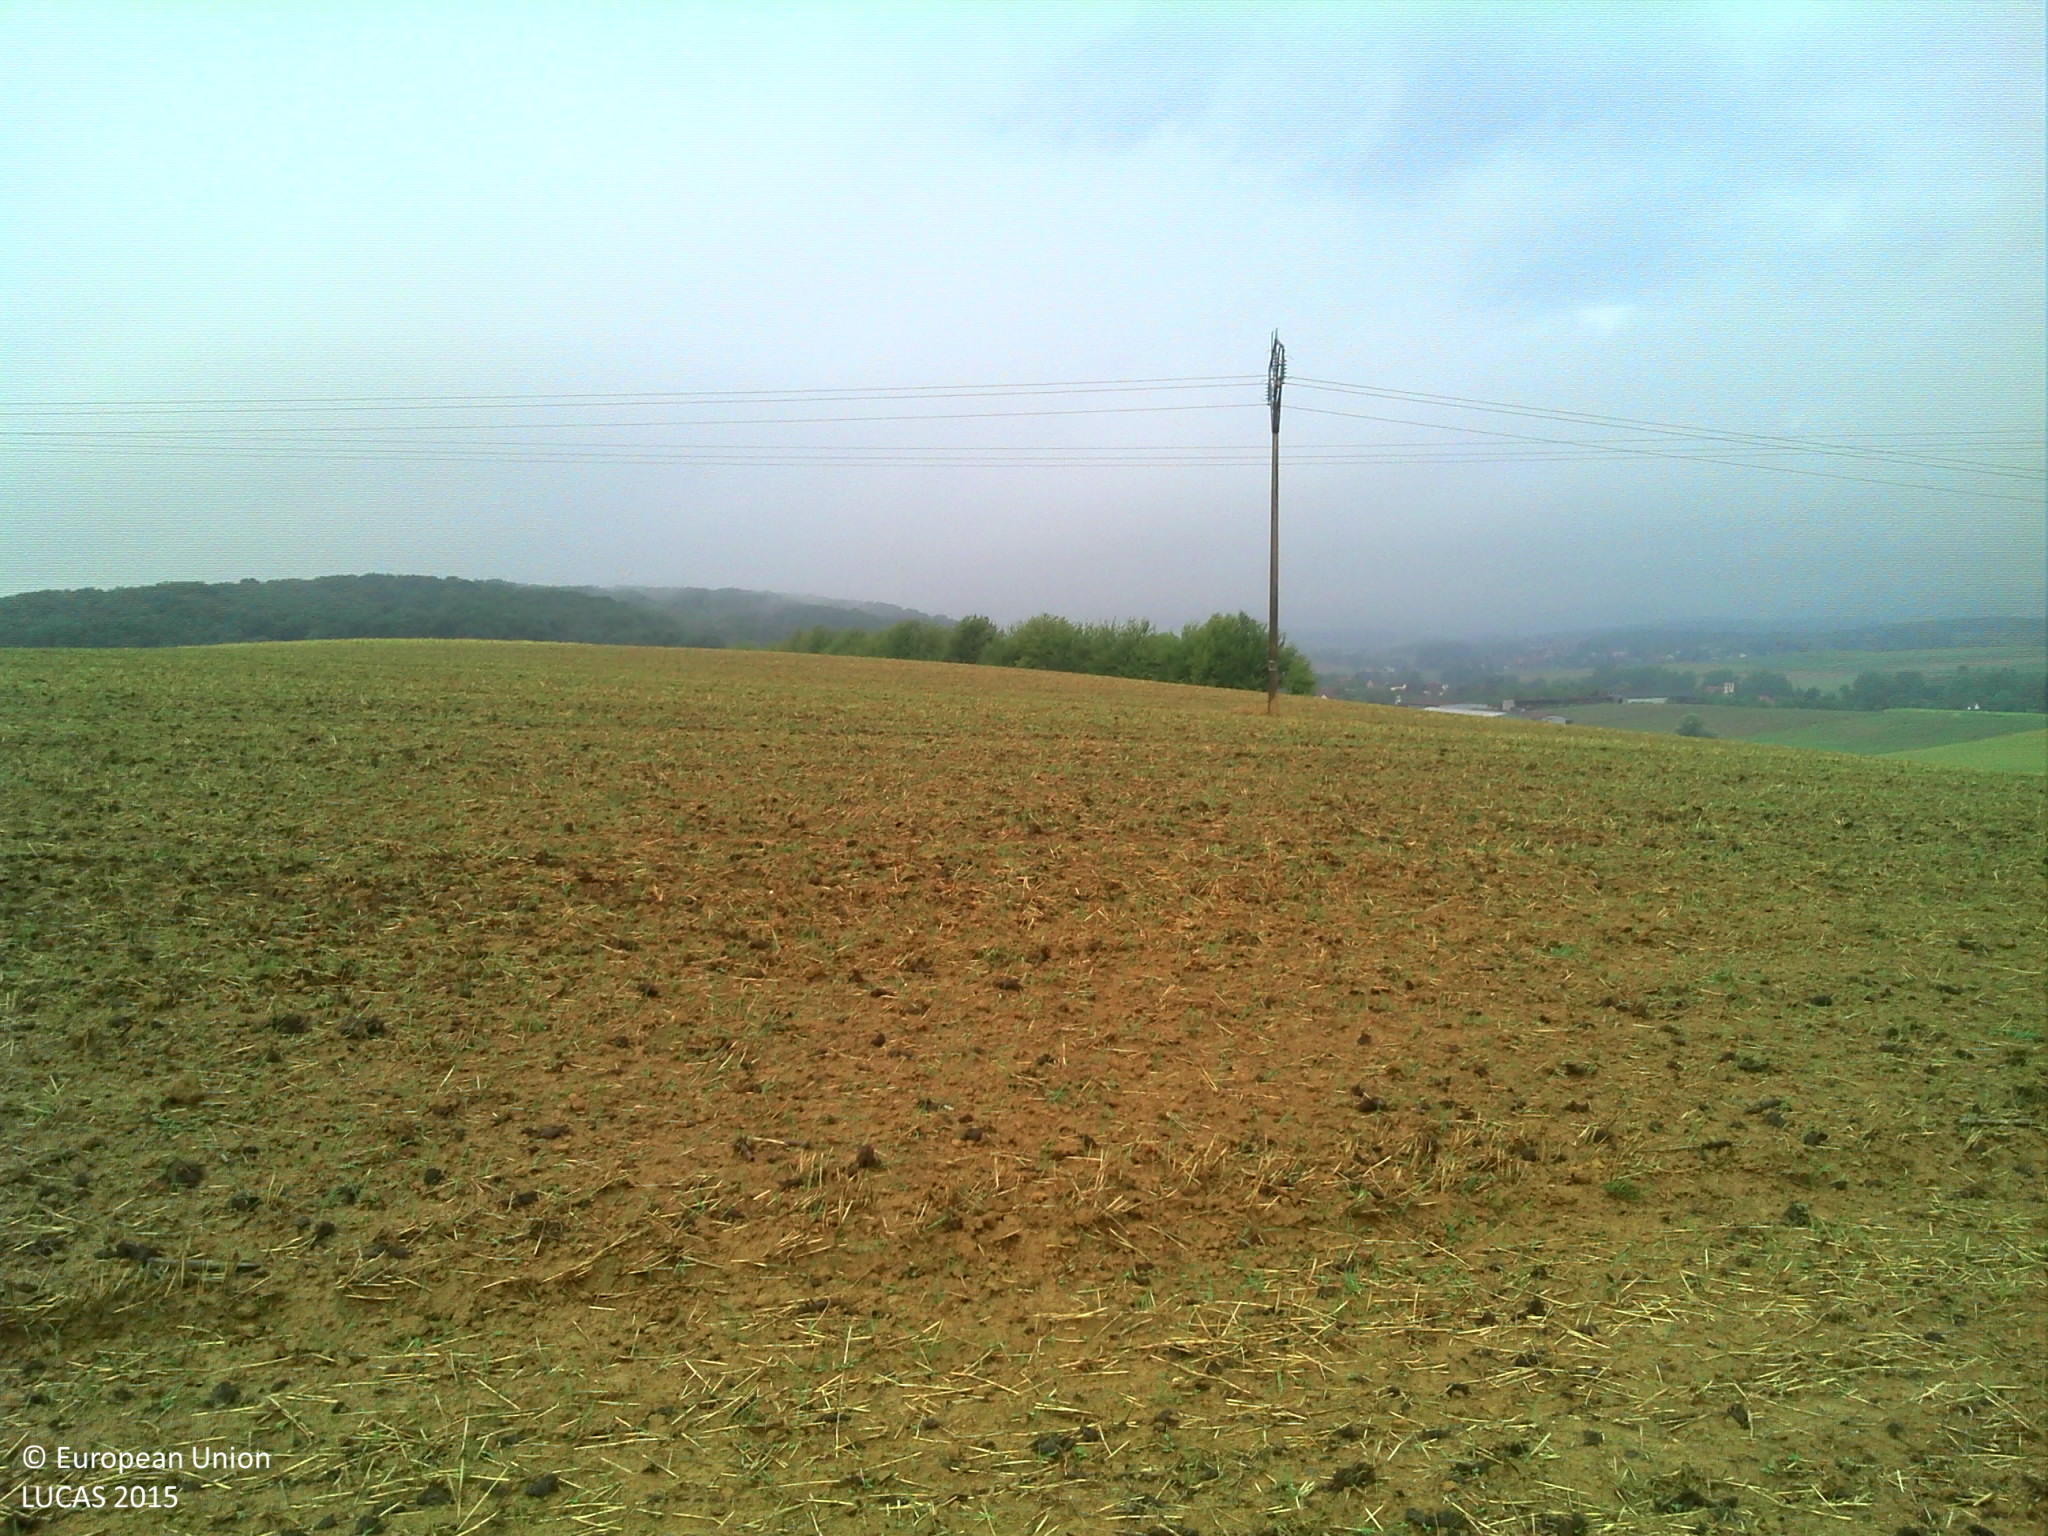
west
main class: Cropland
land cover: Common wheat
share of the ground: 10 - 25 %
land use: Agriculture (excluding fallow land and kitchen gardens)
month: August
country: FR
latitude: 48.8434
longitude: 7.5071
